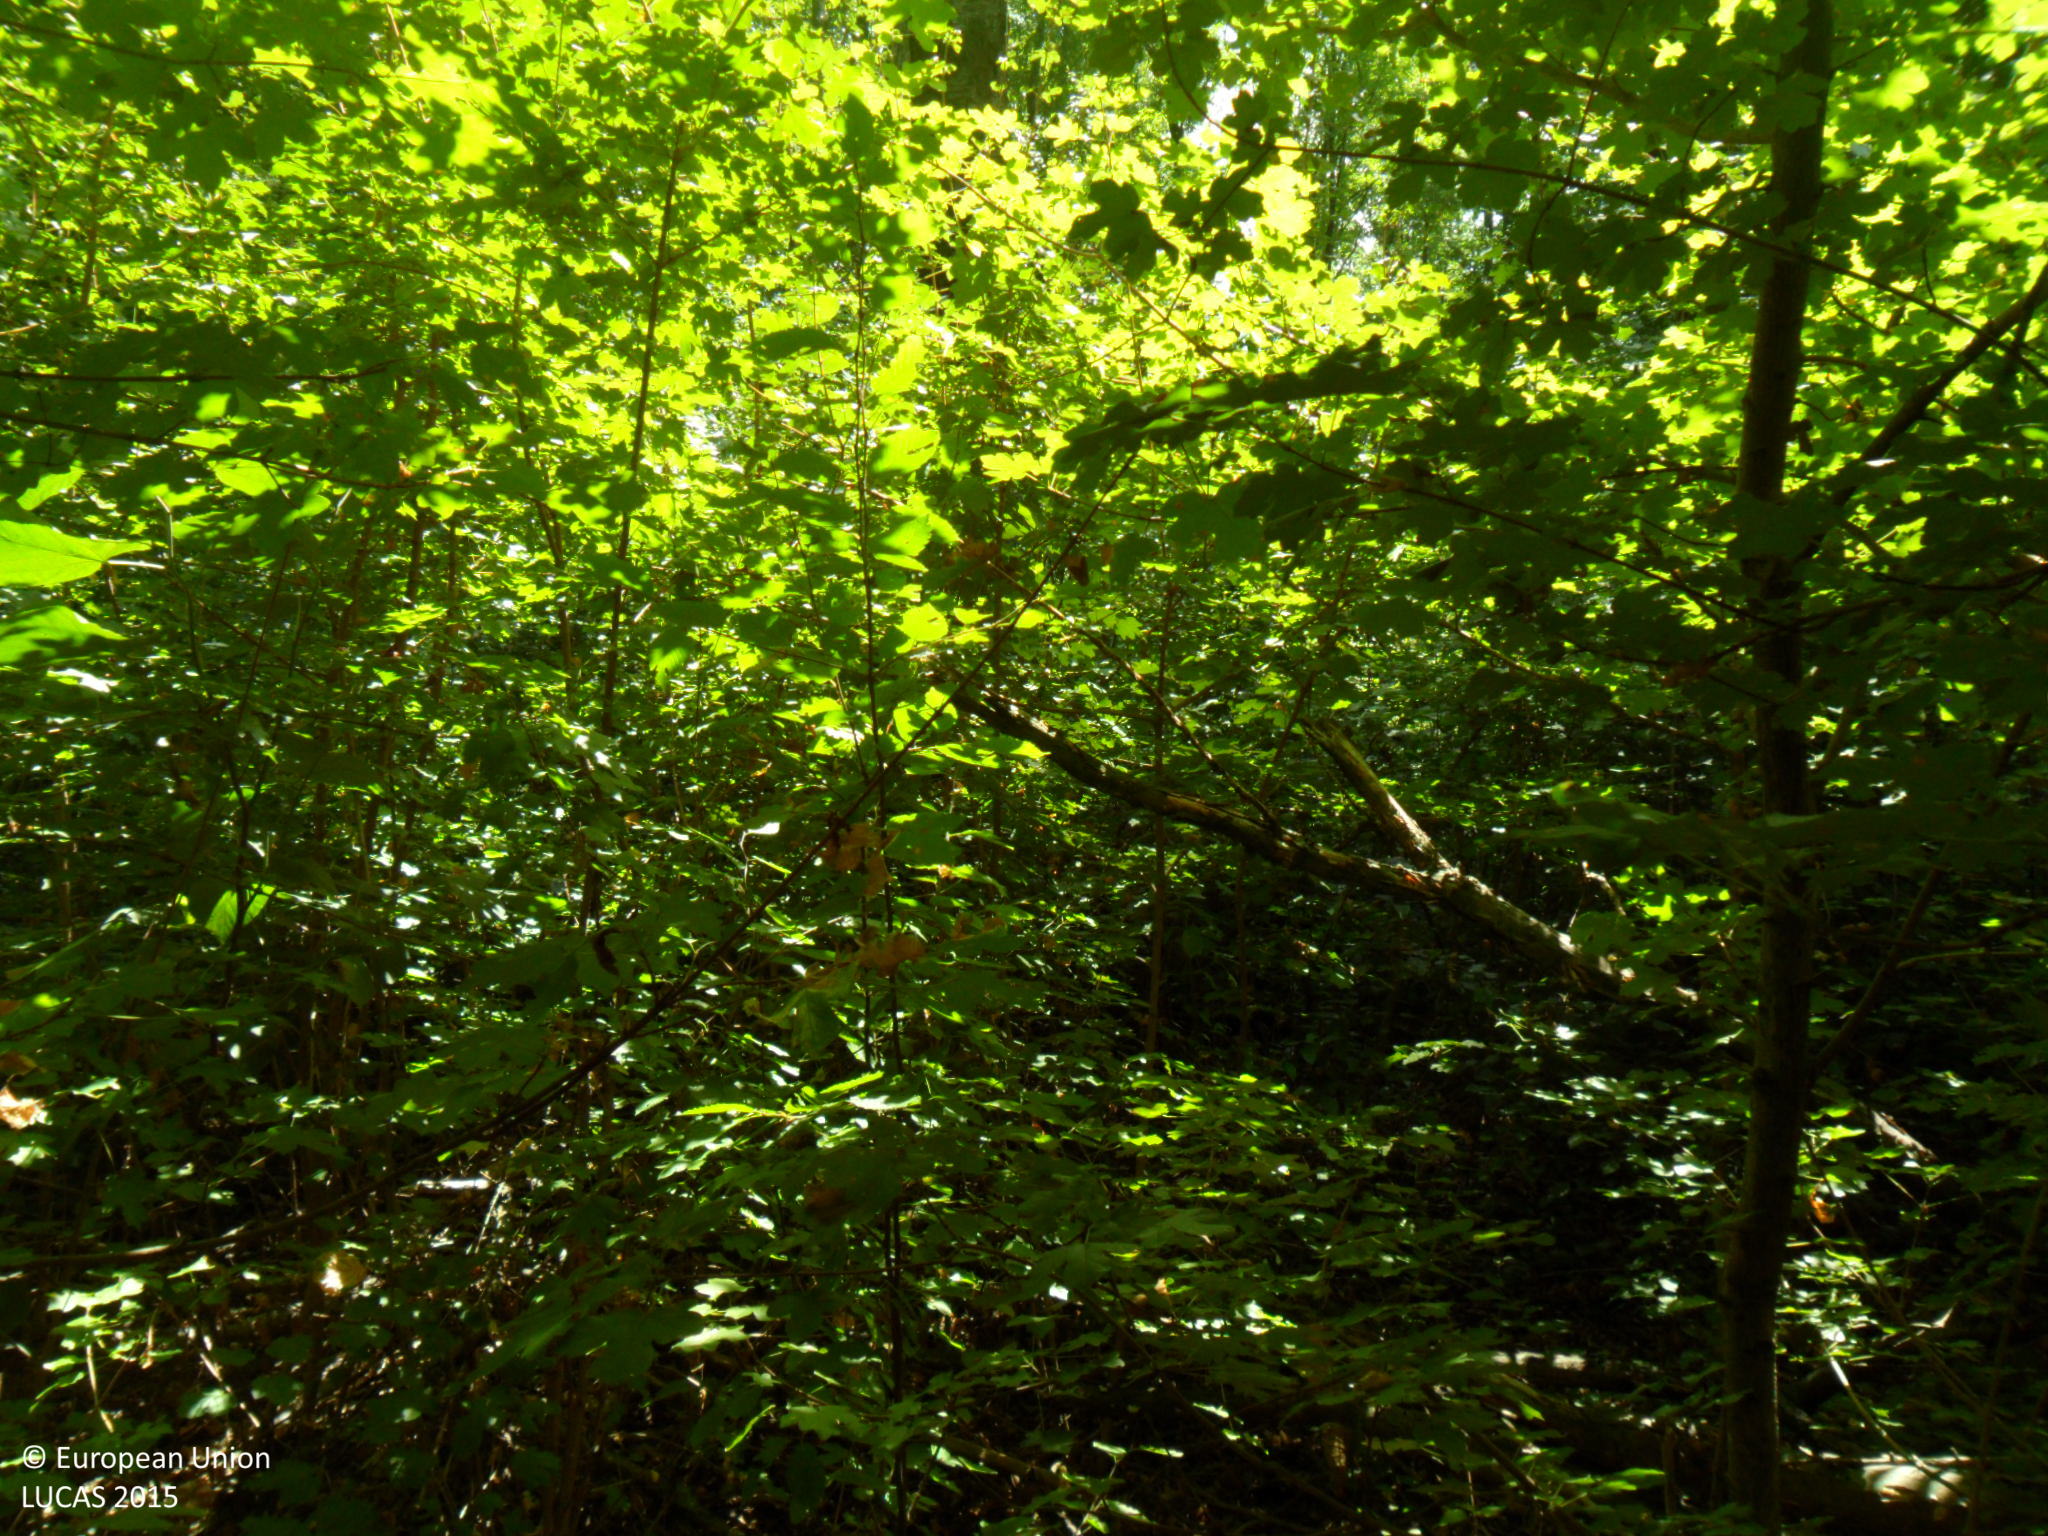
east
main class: Woodland
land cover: Broadleaved woodland
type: mesophytic deciduous forest
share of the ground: > 75 %
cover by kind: broadleaved forest trees 100 %
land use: Forestry
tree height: > 5 m
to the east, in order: Broadleaved woodland; Spontaneously vegetated surfaces; Broadleaved woodland; Tracks; Broadleaved woodland
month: August
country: BG
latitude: 43.5580
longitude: 26.6859
